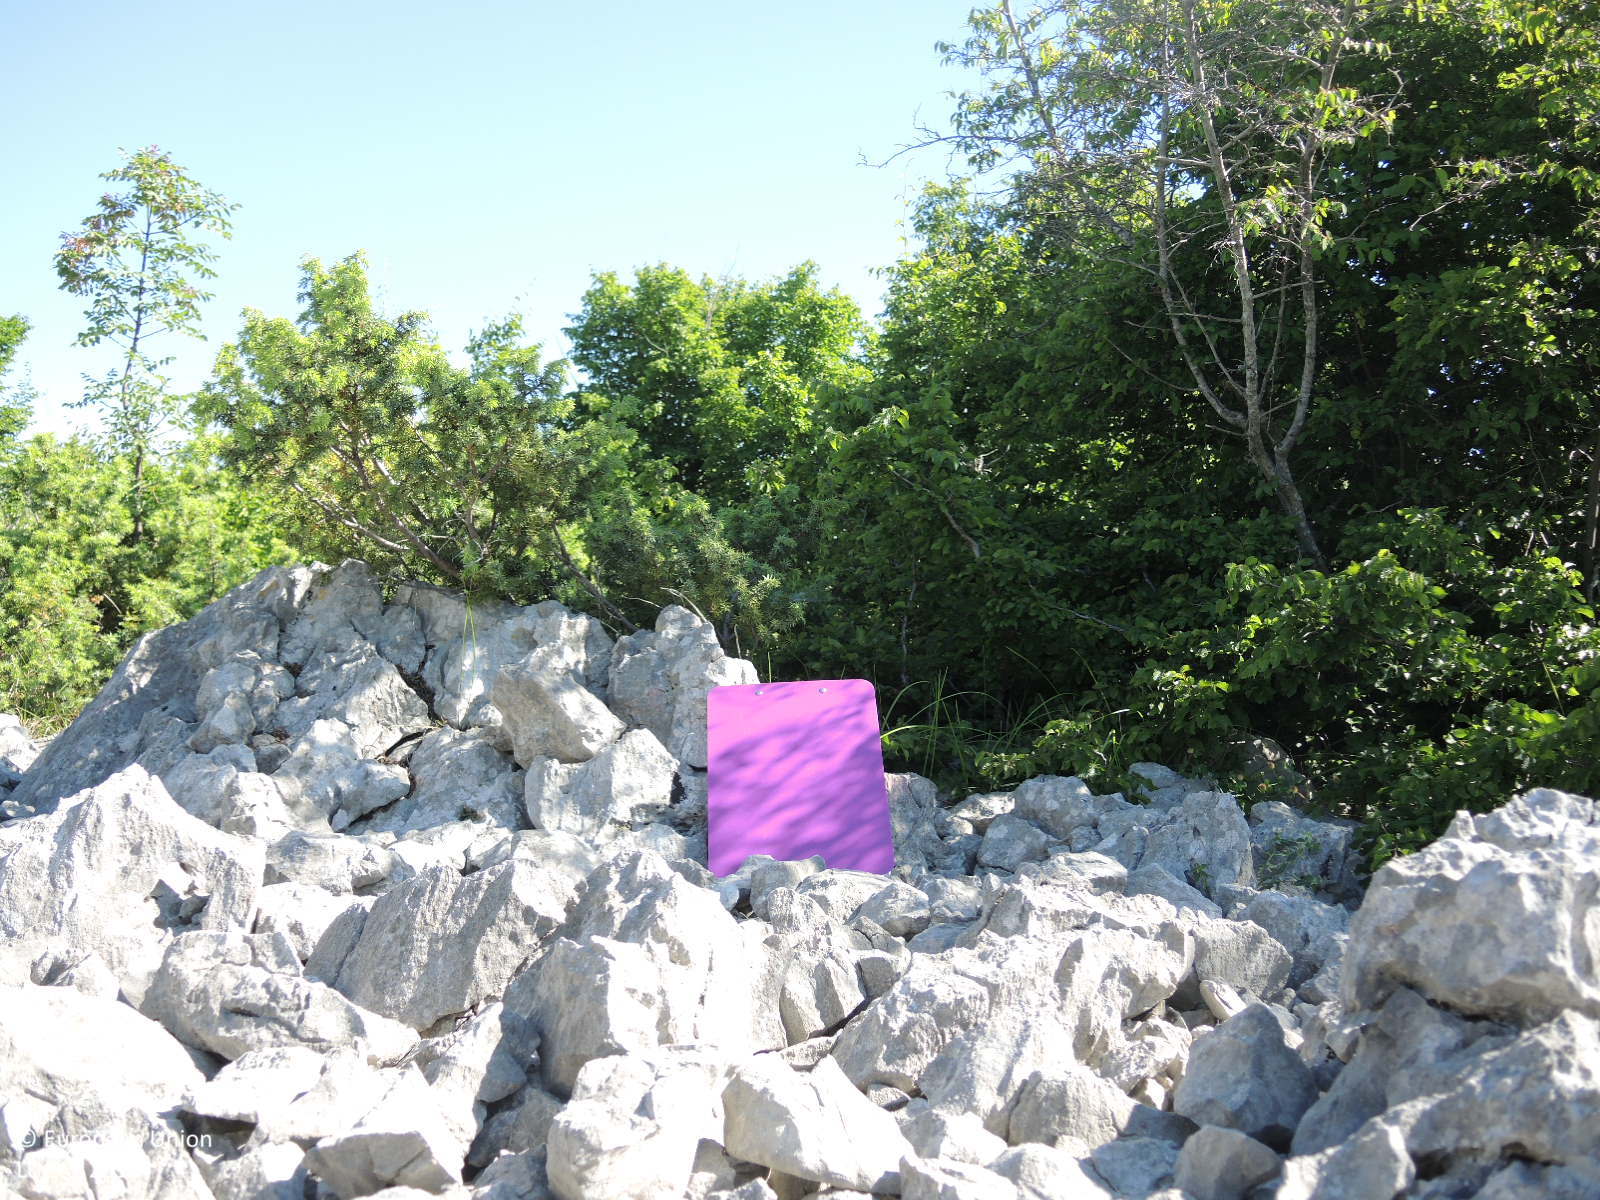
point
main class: Shrubland
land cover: Shrubland with sparse tree cover
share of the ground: 50 - 75 %
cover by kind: shrubs 50 %, unconsolidated bare surface 30 %, herbaceous plants 10 %, broadleaved forest trees 5 %, consolidated bare surface 5 %
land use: Semi-natural and natural areas not in use
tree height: < 5 m
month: May
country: HR
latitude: 43.9290
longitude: 15.9084
